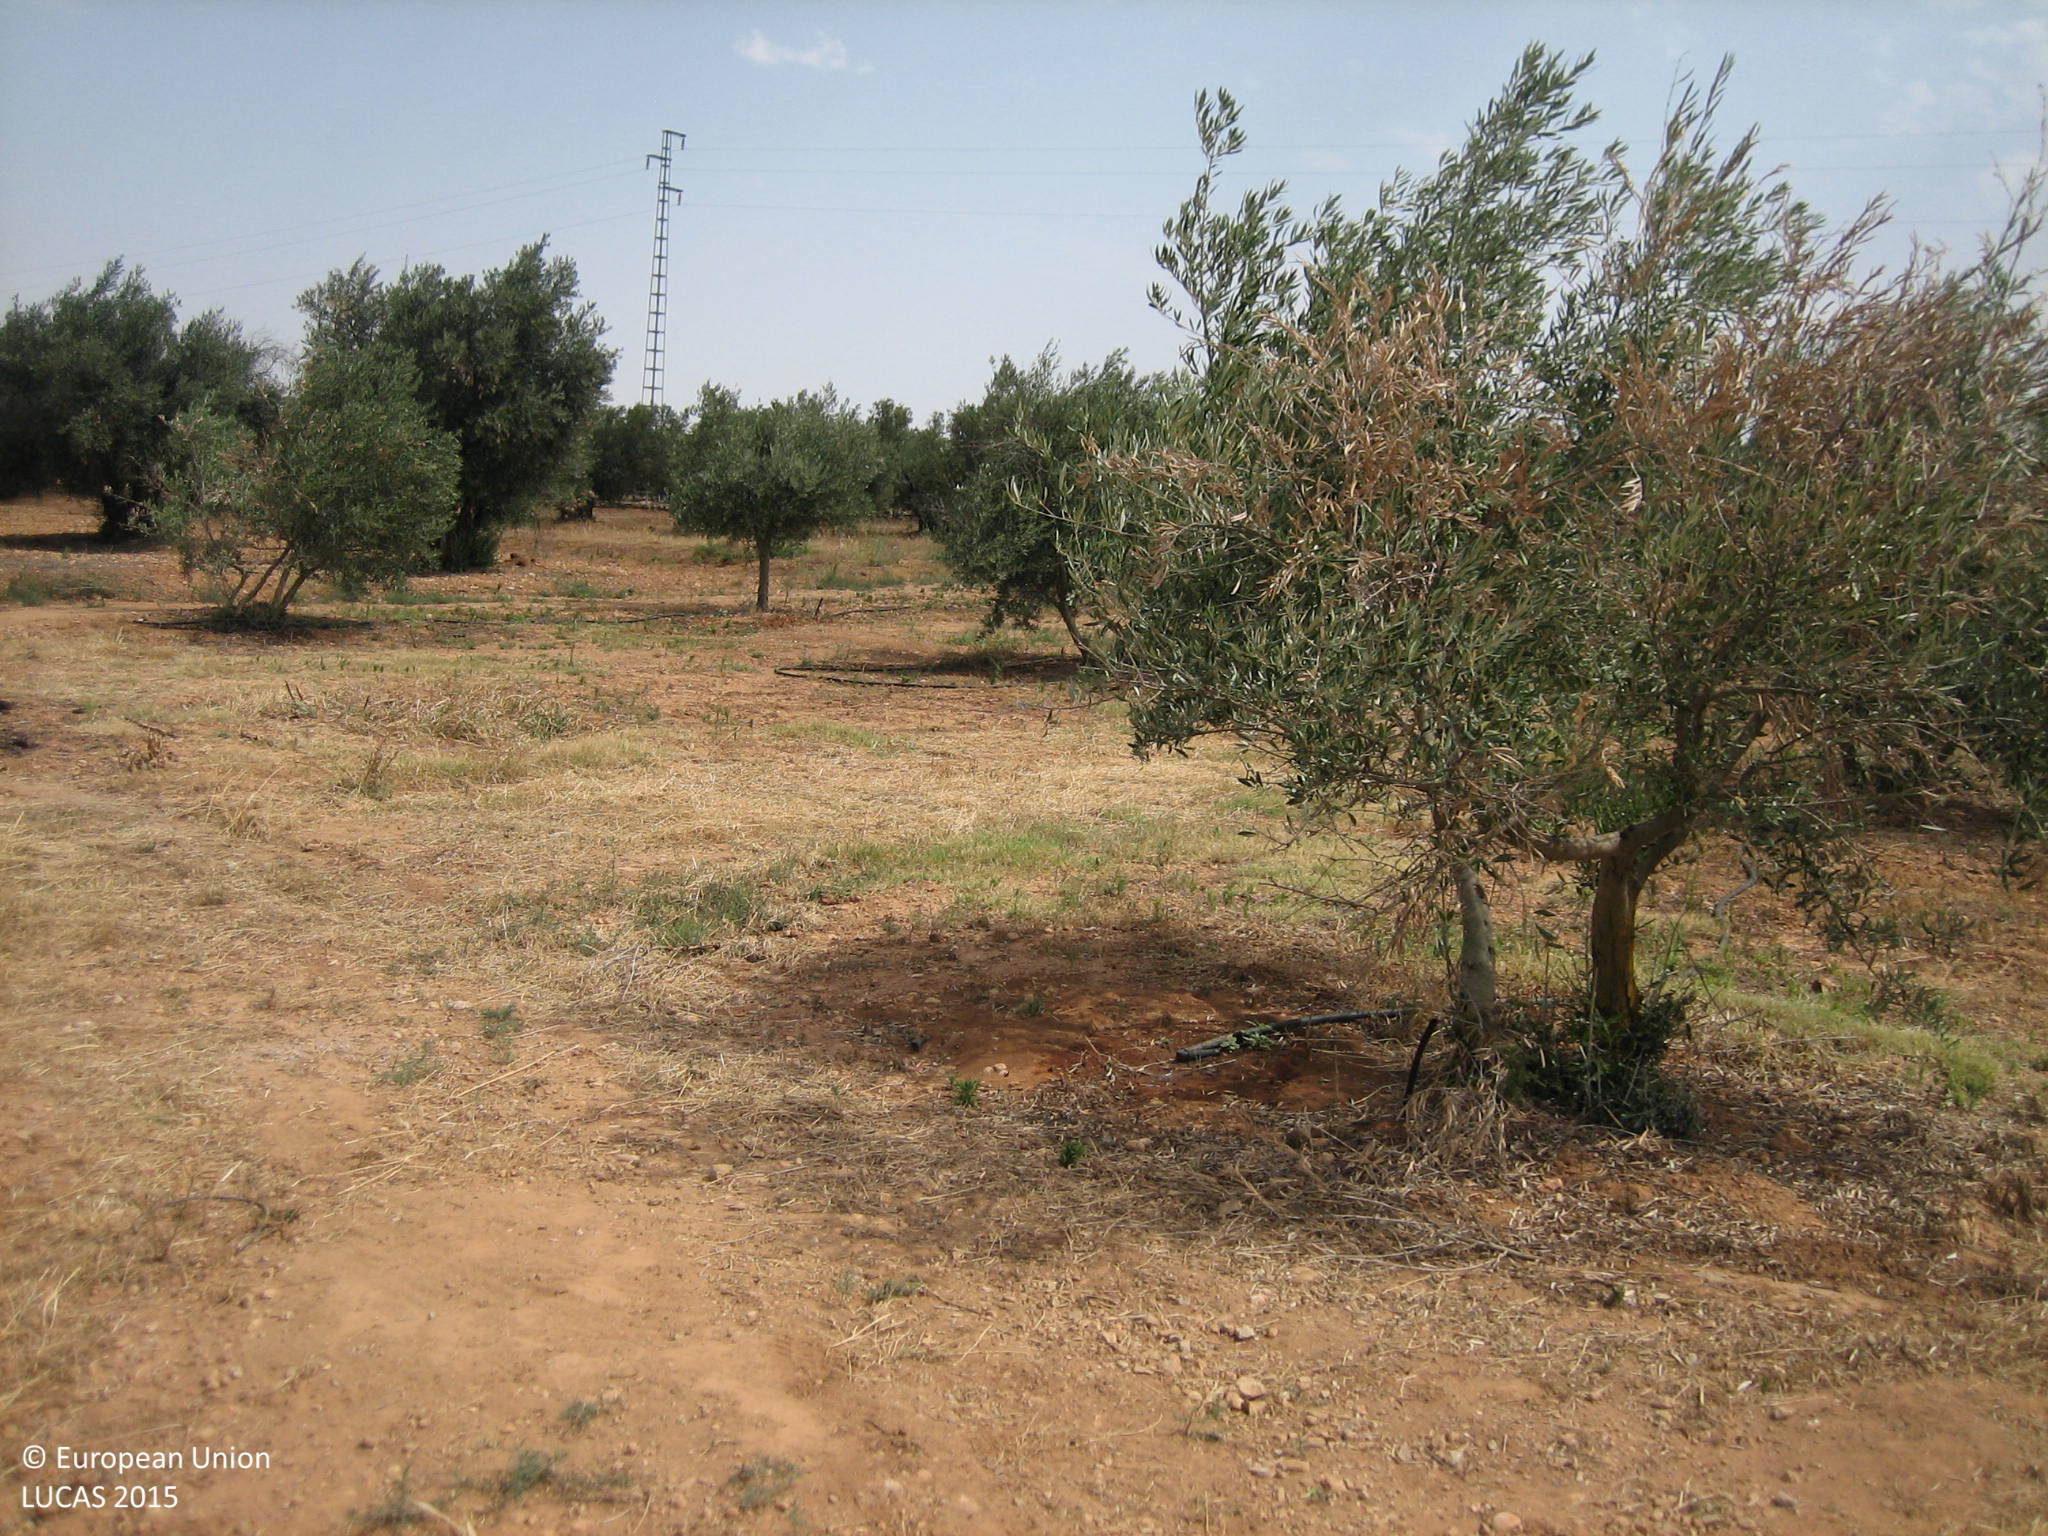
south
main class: Cropland
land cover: Vineyards
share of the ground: 25 - 50 %
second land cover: Spontaneously vegetated surfaces
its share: > 75 %
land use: Agriculture (excluding fallow land and kitchen gardens)
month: July
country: ES
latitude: 37.6830
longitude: -2.9521
